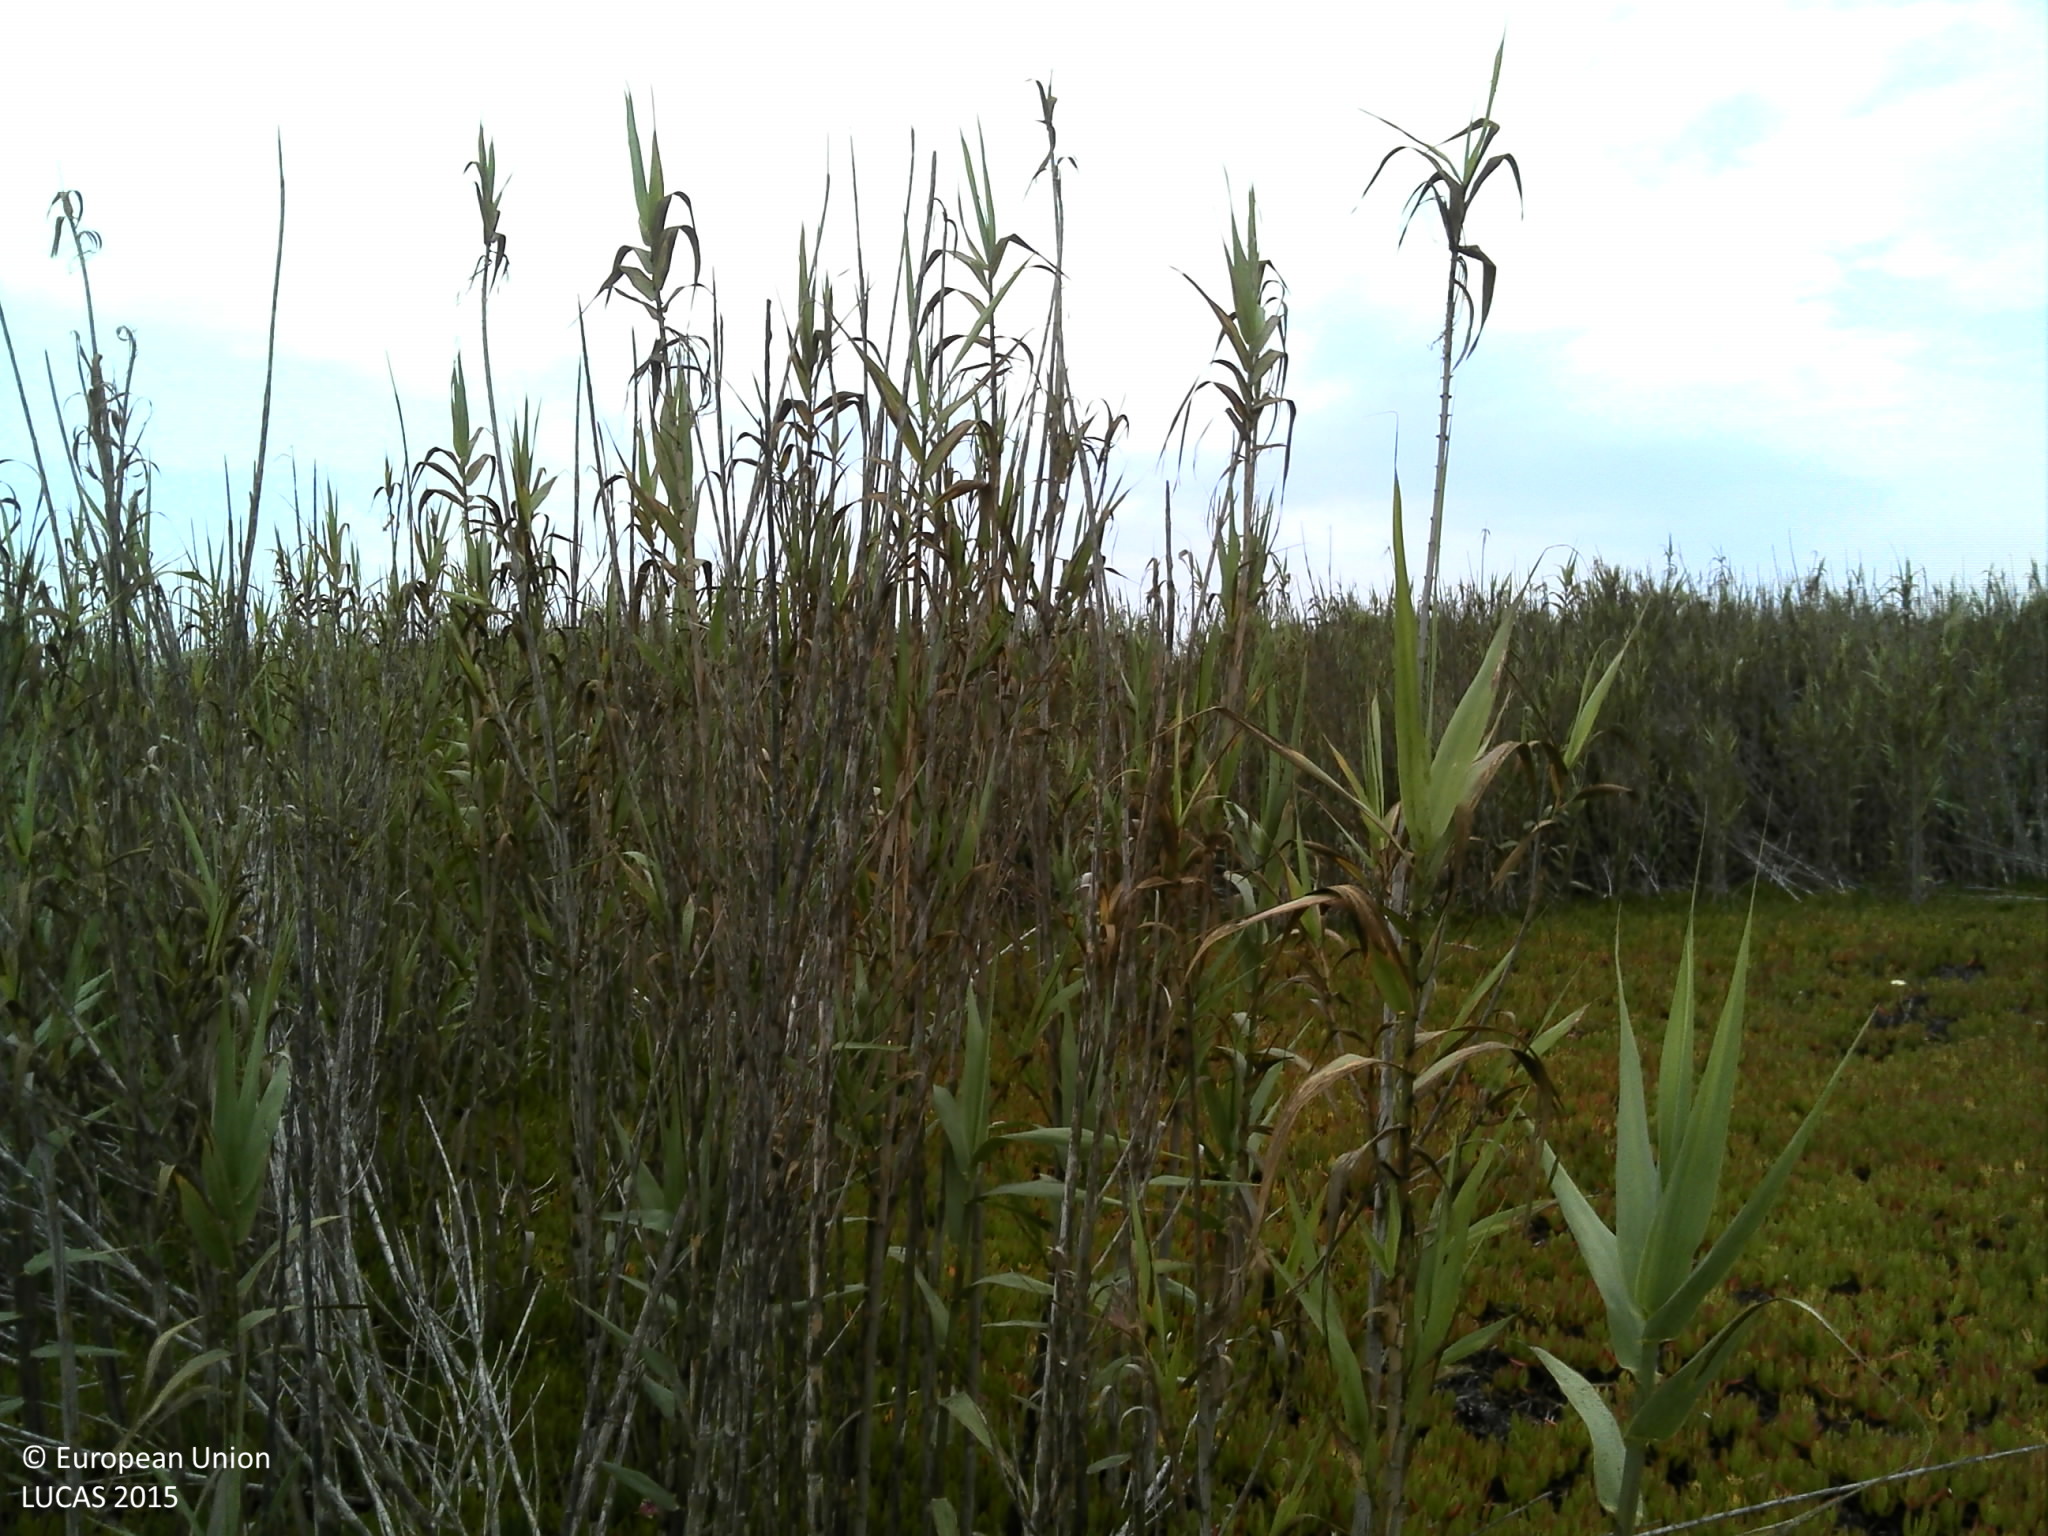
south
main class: Shrubland
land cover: Shrubland without tree cover
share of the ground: 50 - 75 %
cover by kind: shrubs 75 %, herbaceous plants 15 %, unconsolidated bare surface 10 %
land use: Semi-natural and natural areas not in use
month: June
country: PT
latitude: 39.3671
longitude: -9.3983
